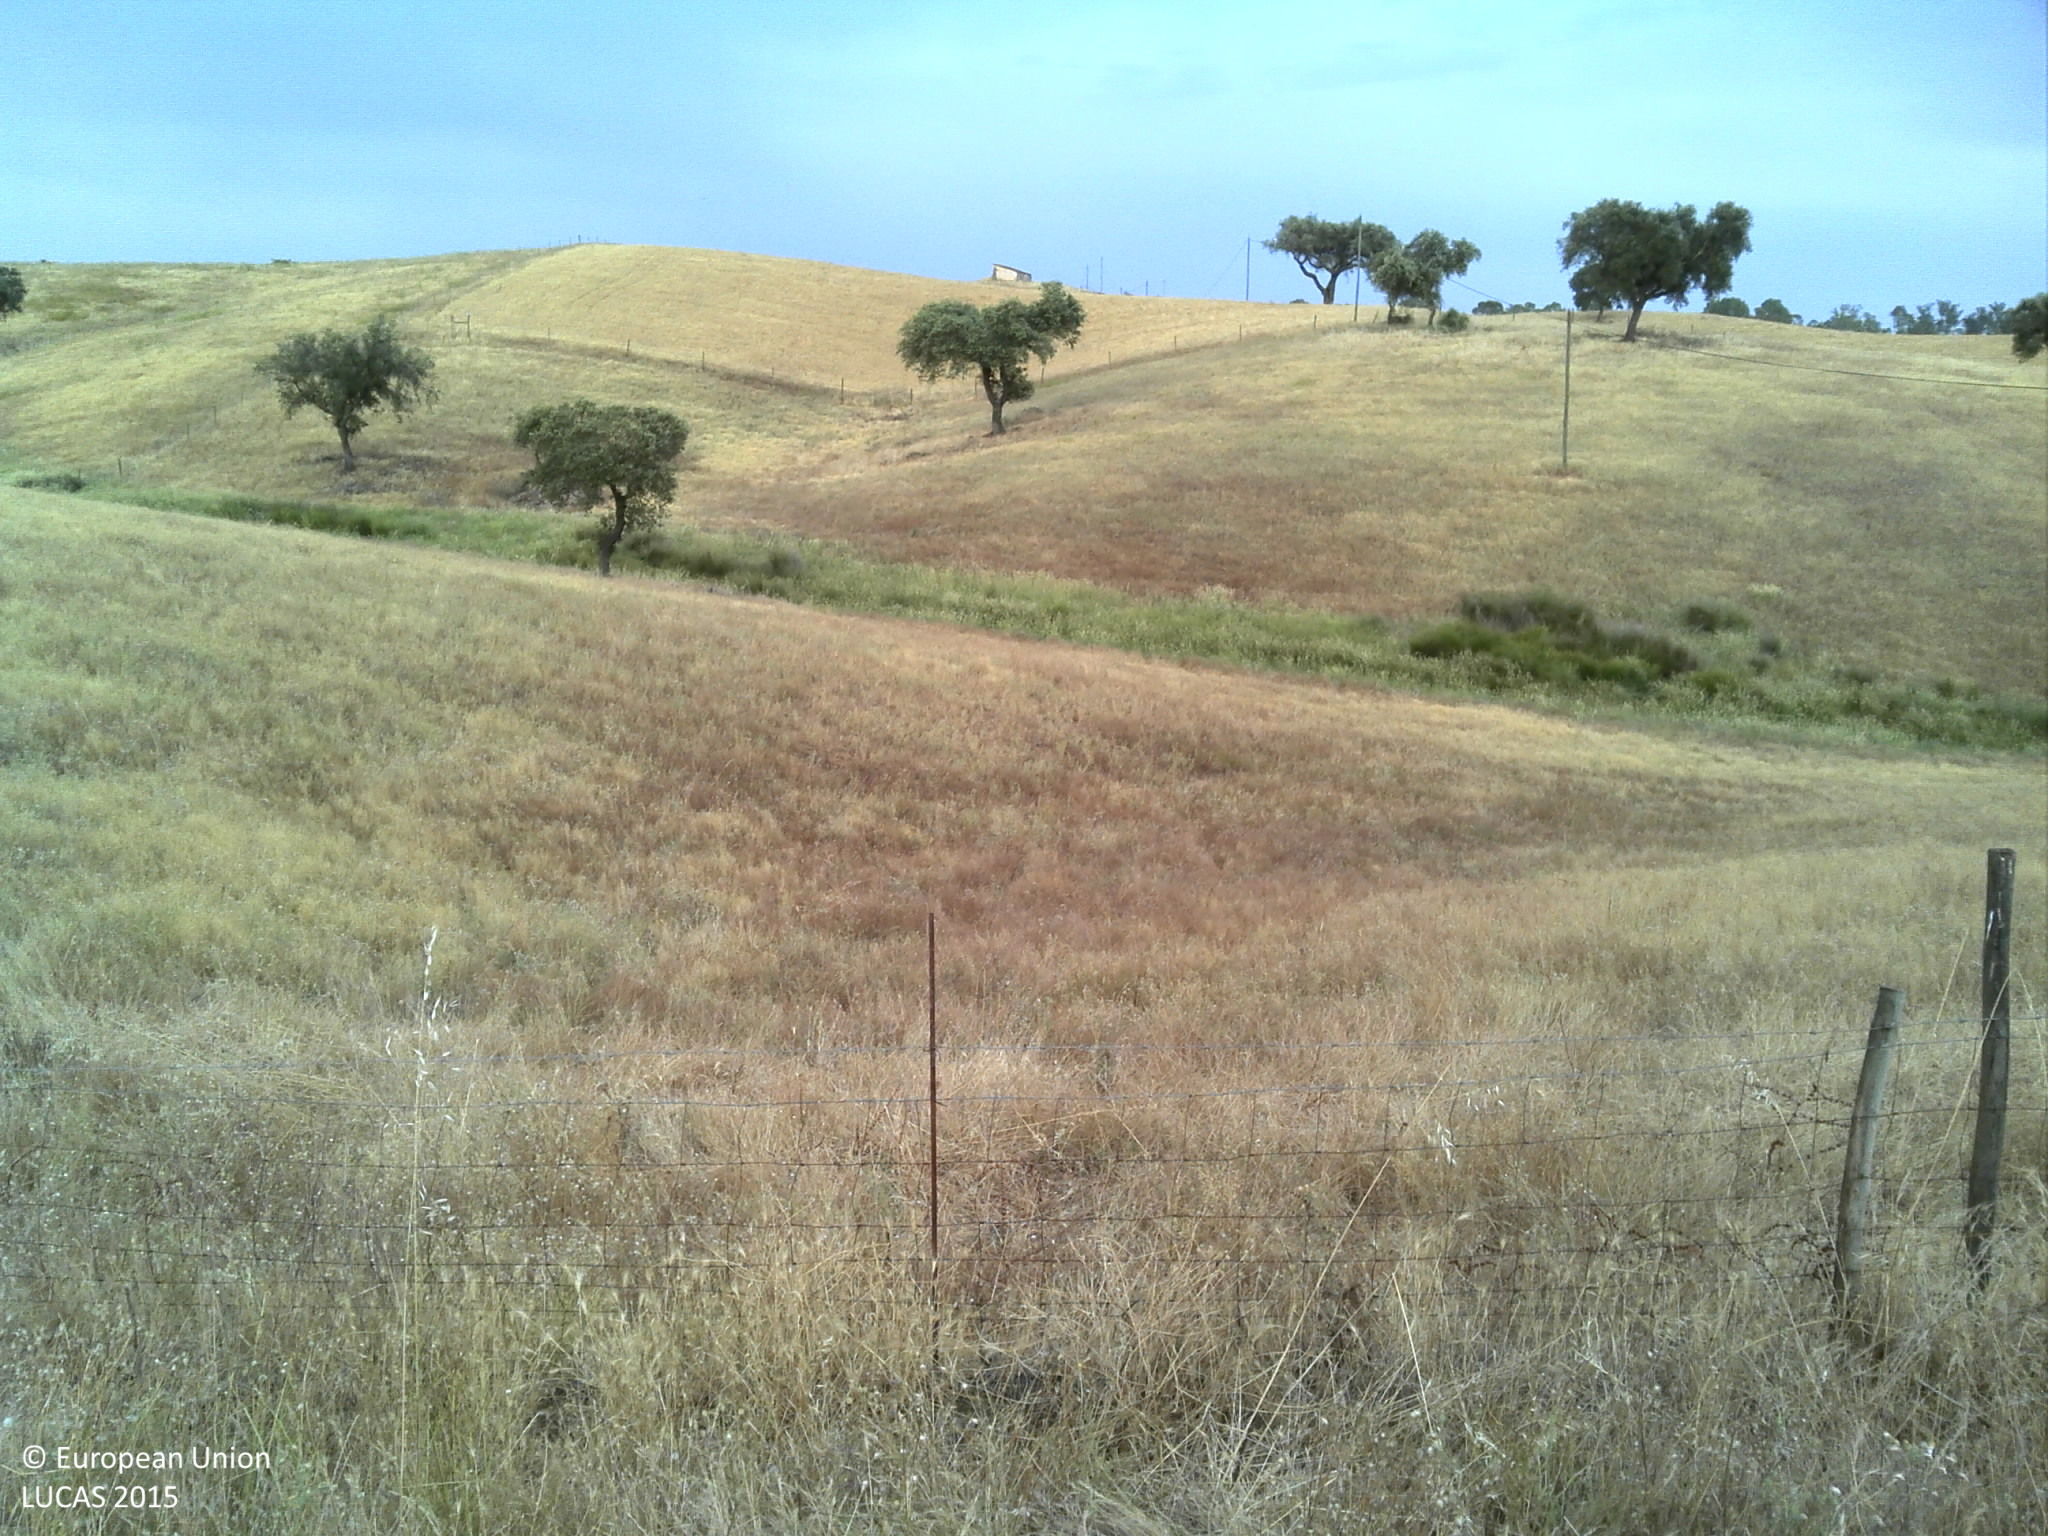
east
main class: Grassland
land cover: Grassland without tree/shrub cover
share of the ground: > 75 %
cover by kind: herbaceous plants 100 %
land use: Agriculture (excluding fallow land and kitchen gardens)
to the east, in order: Grassland without tree/shrub cover; Fences; Grassland without tree/shrub cover; Ditches and canals; Grassland without tree/shrub cover; Single bushes/trees; Grassland without tree/shrub cover; Fences; Grass margins; Oats
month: June
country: PT
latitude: 37.7476
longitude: -7.5497
